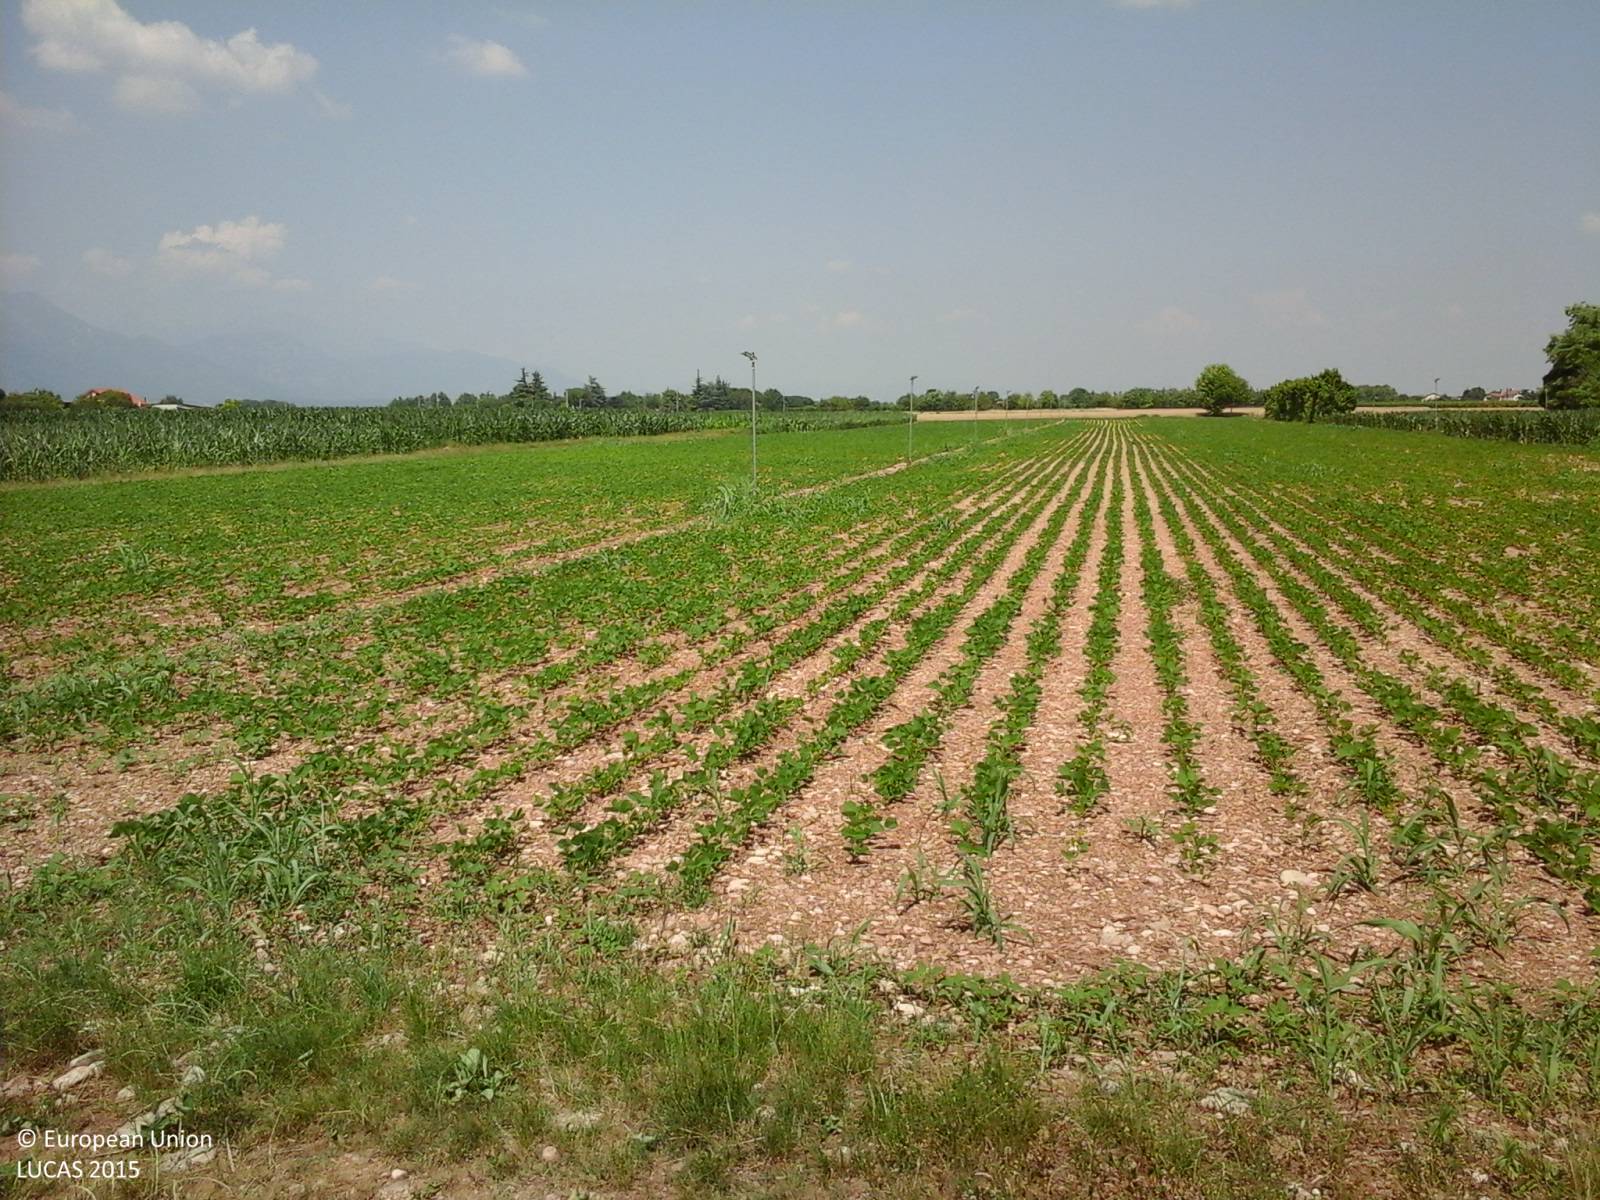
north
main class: Cropland
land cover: Common wheat
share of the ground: > 75 %
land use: Agriculture (excluding fallow land and kitchen gardens)
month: June
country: IT
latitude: 45.9960
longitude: 12.5661
